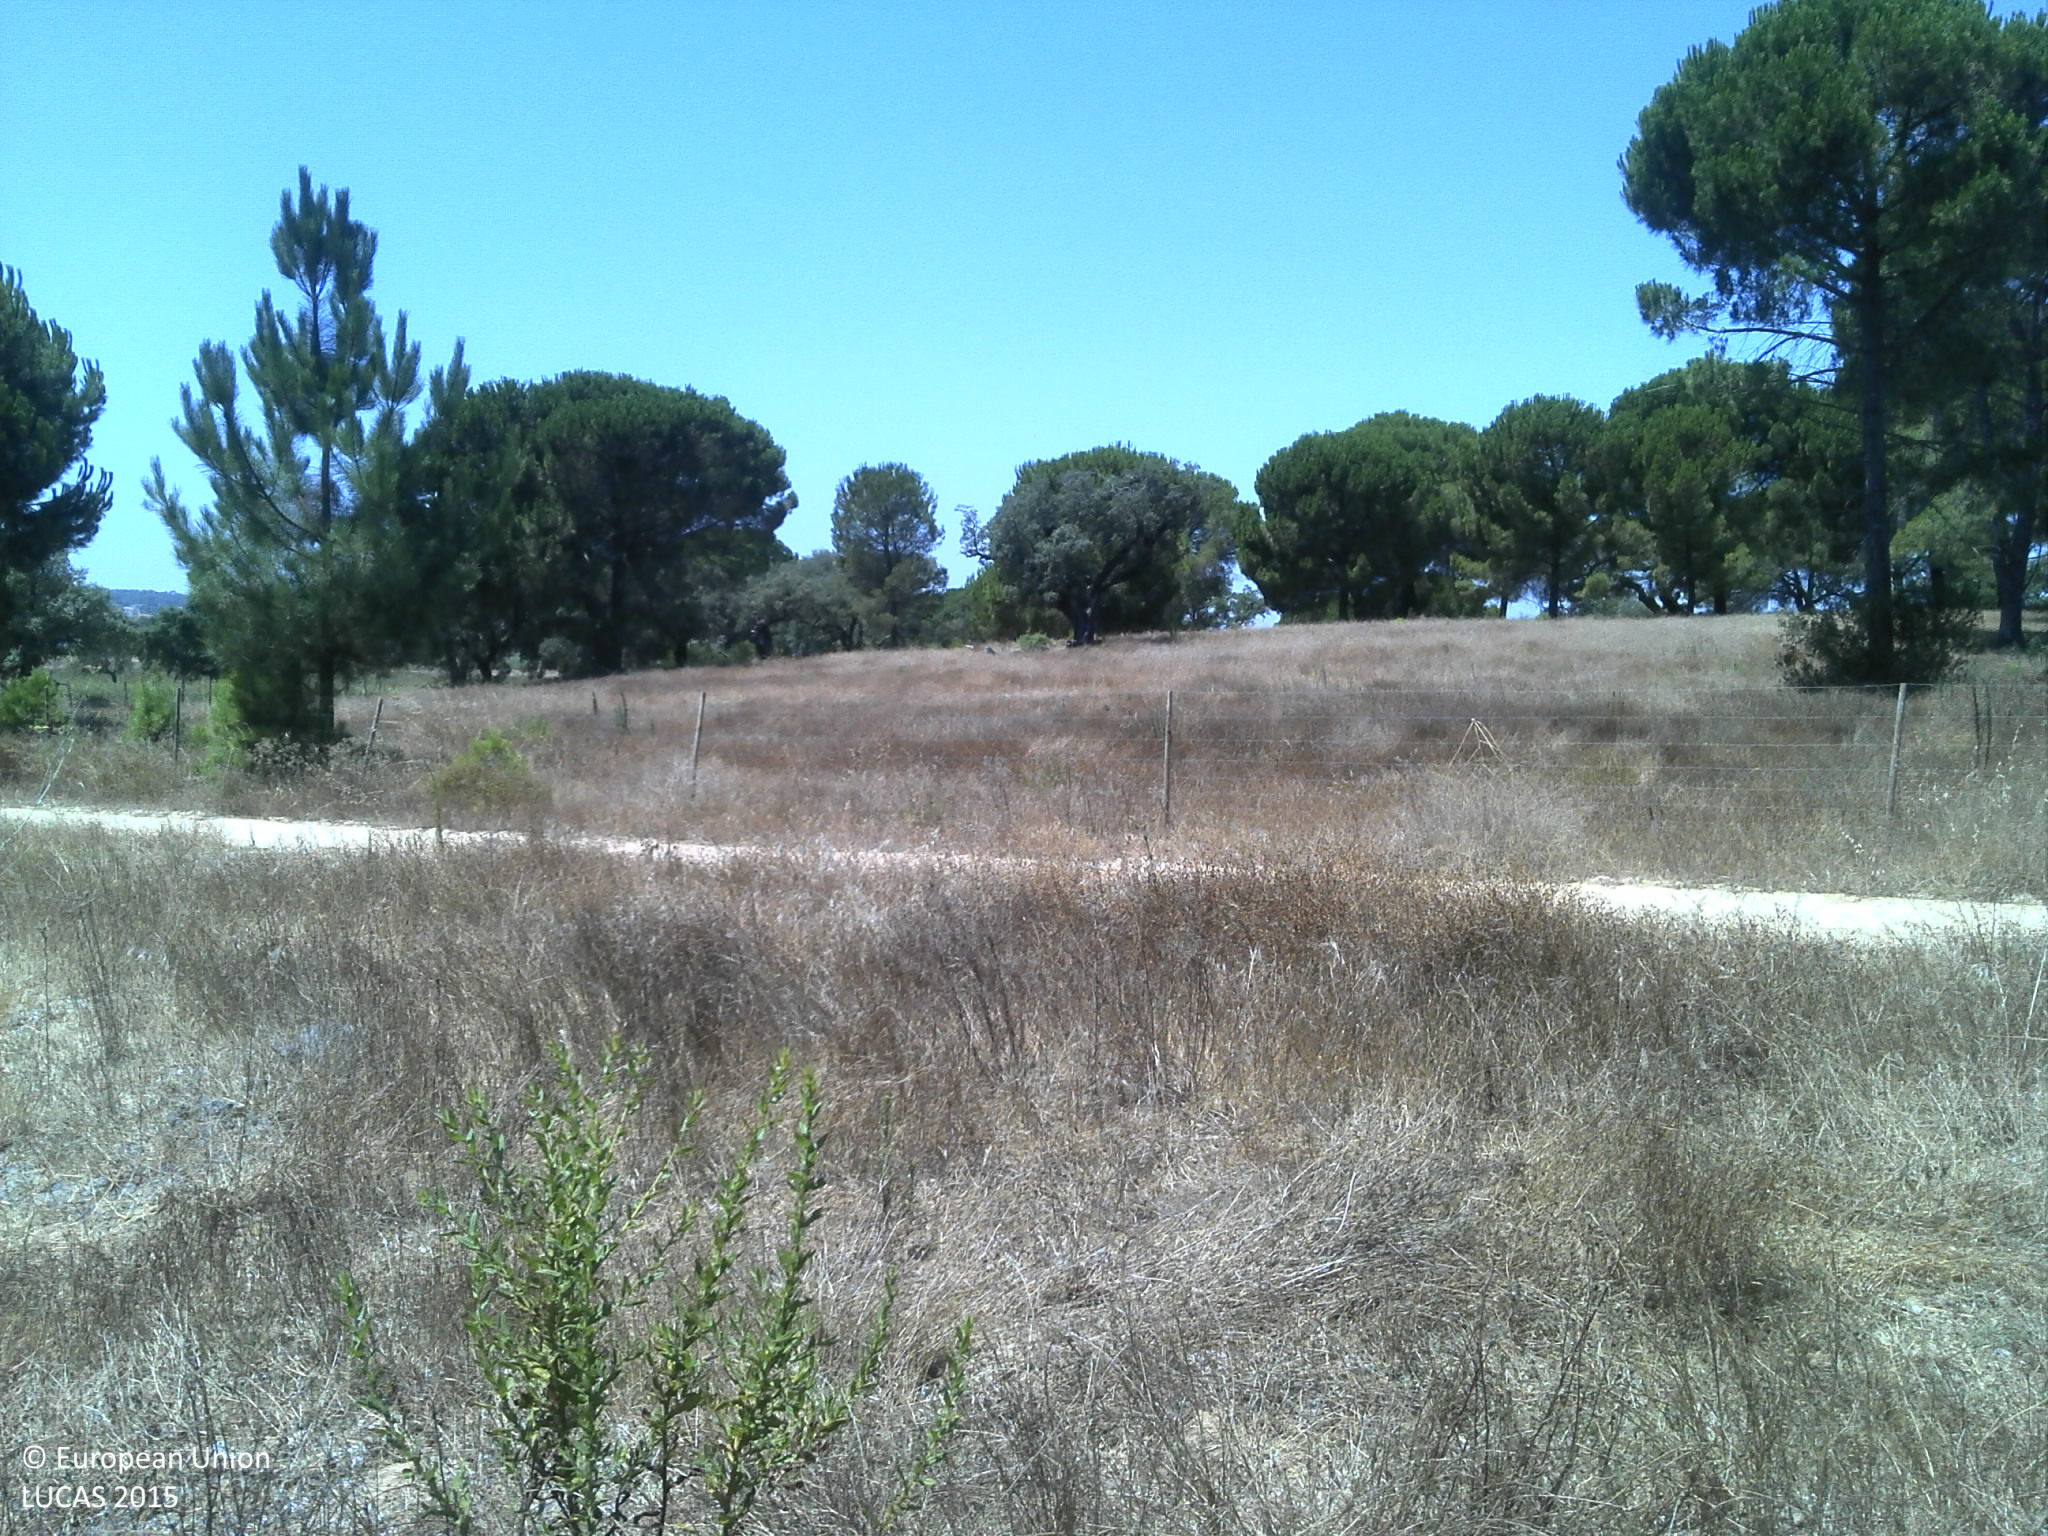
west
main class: Grassland
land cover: Spontaneously vegetated surfaces
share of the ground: 50 - 75 %
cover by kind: herbaceous plants 90 %, unconsolidated bare surface 10 %
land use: Fallow land
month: July
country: PT
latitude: 38.9985
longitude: -8.2654
